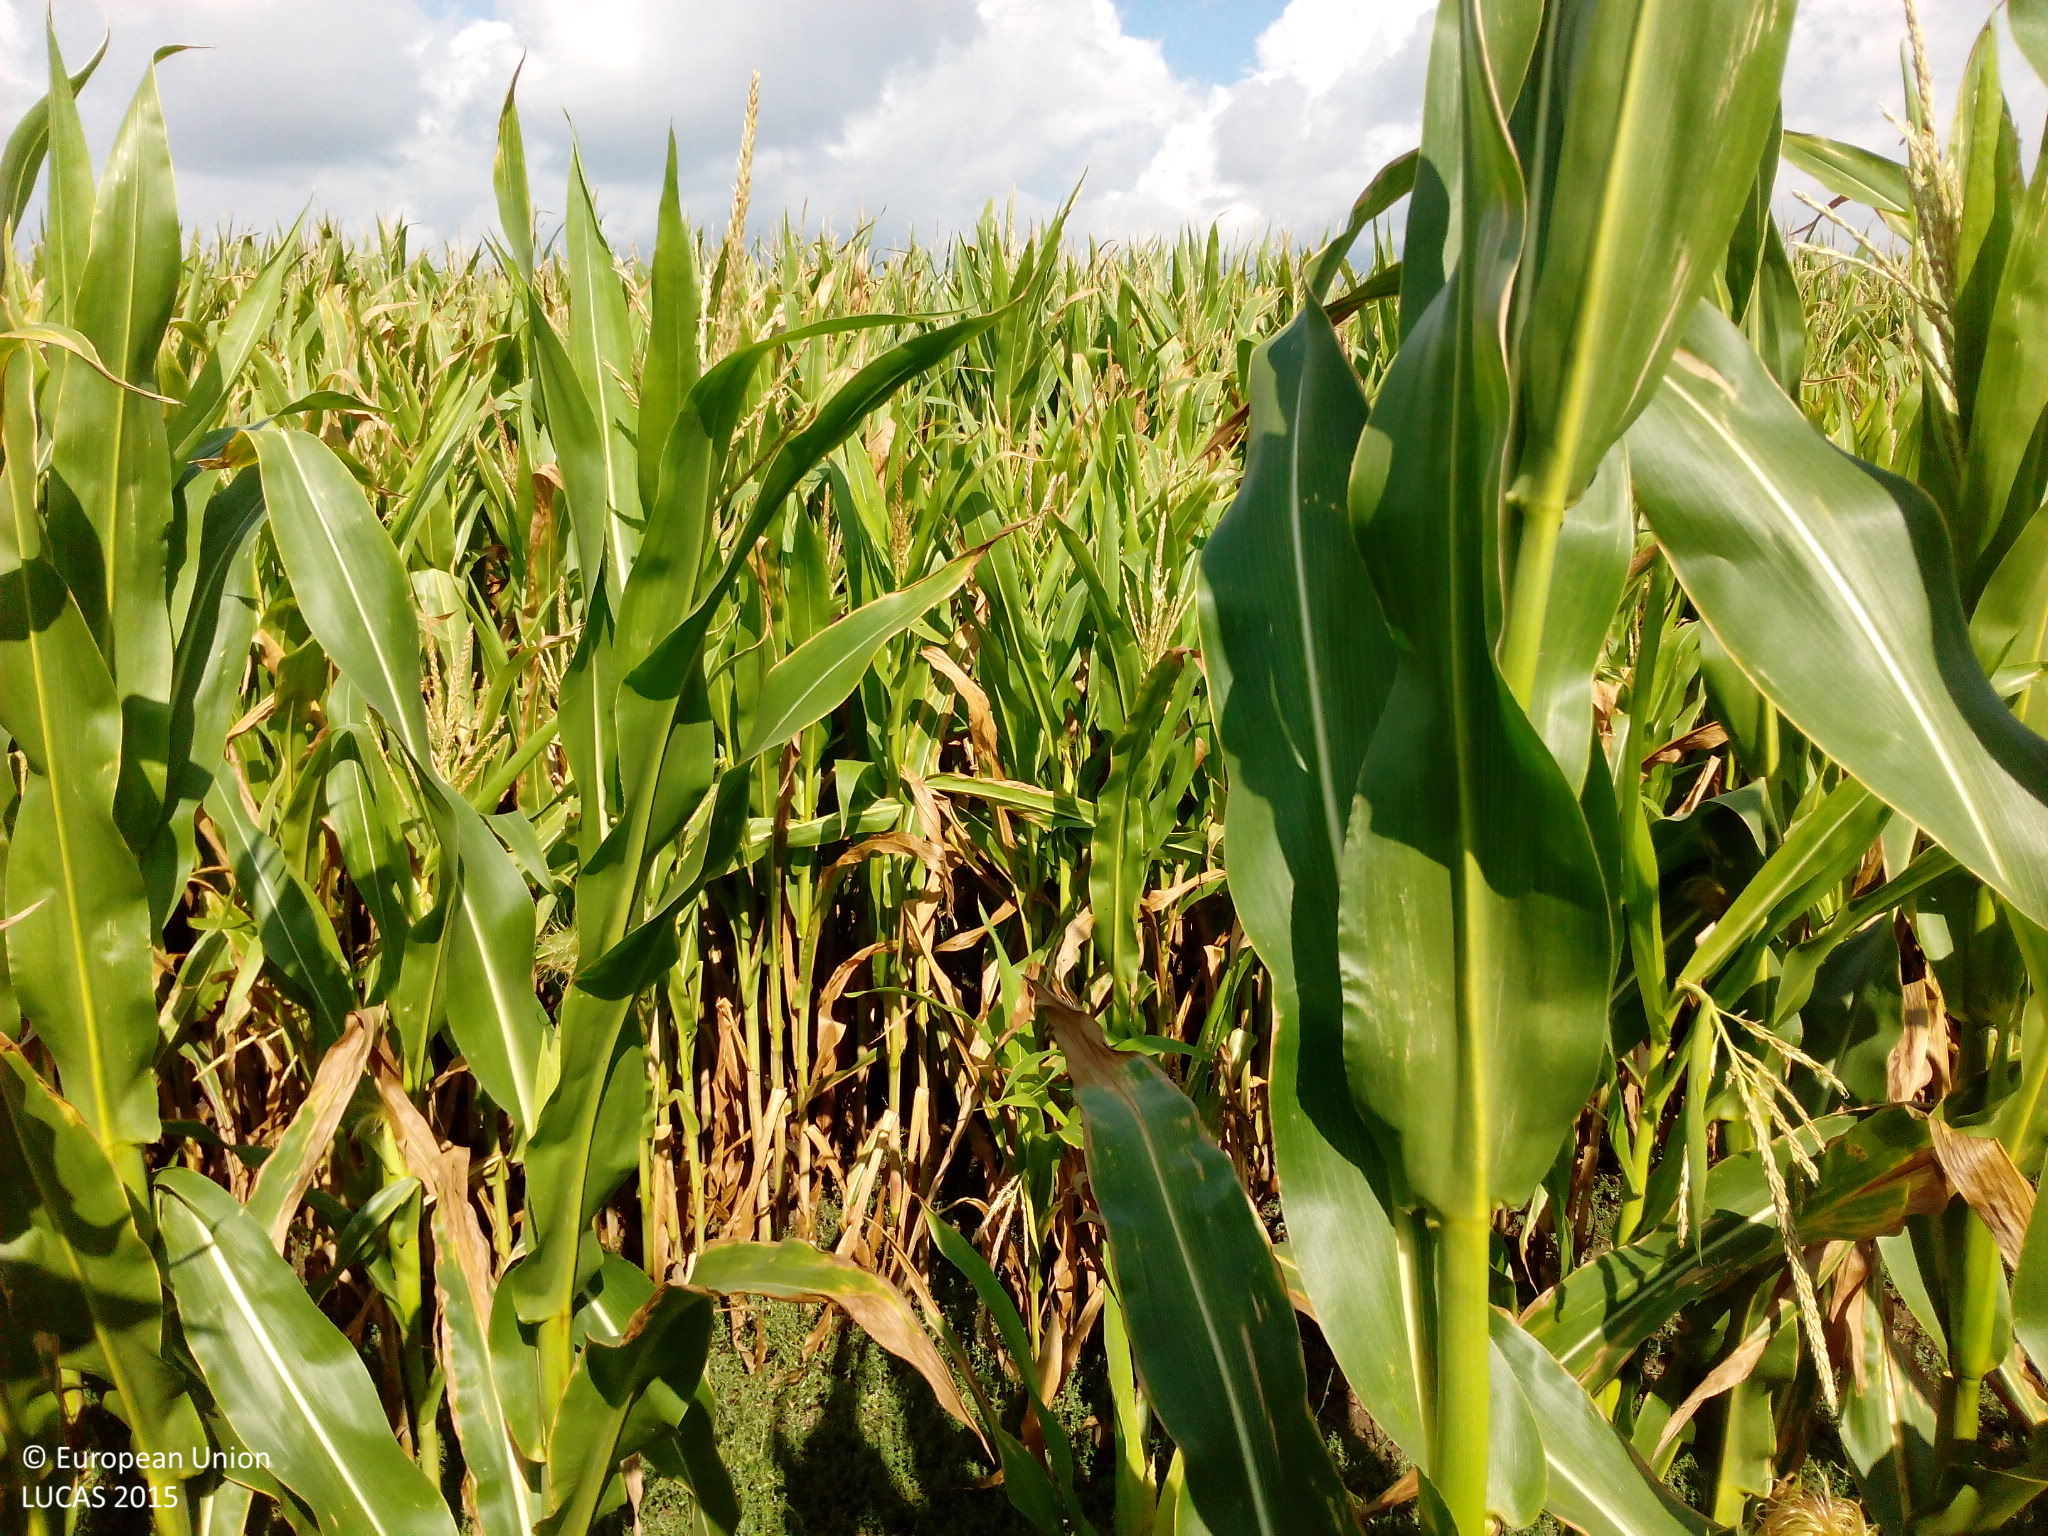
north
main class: Cropland
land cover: Maize
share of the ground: > 75 %
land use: Agriculture (excluding fallow land and kitchen gardens)
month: August
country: DE
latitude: 54.0206
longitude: 12.6396
